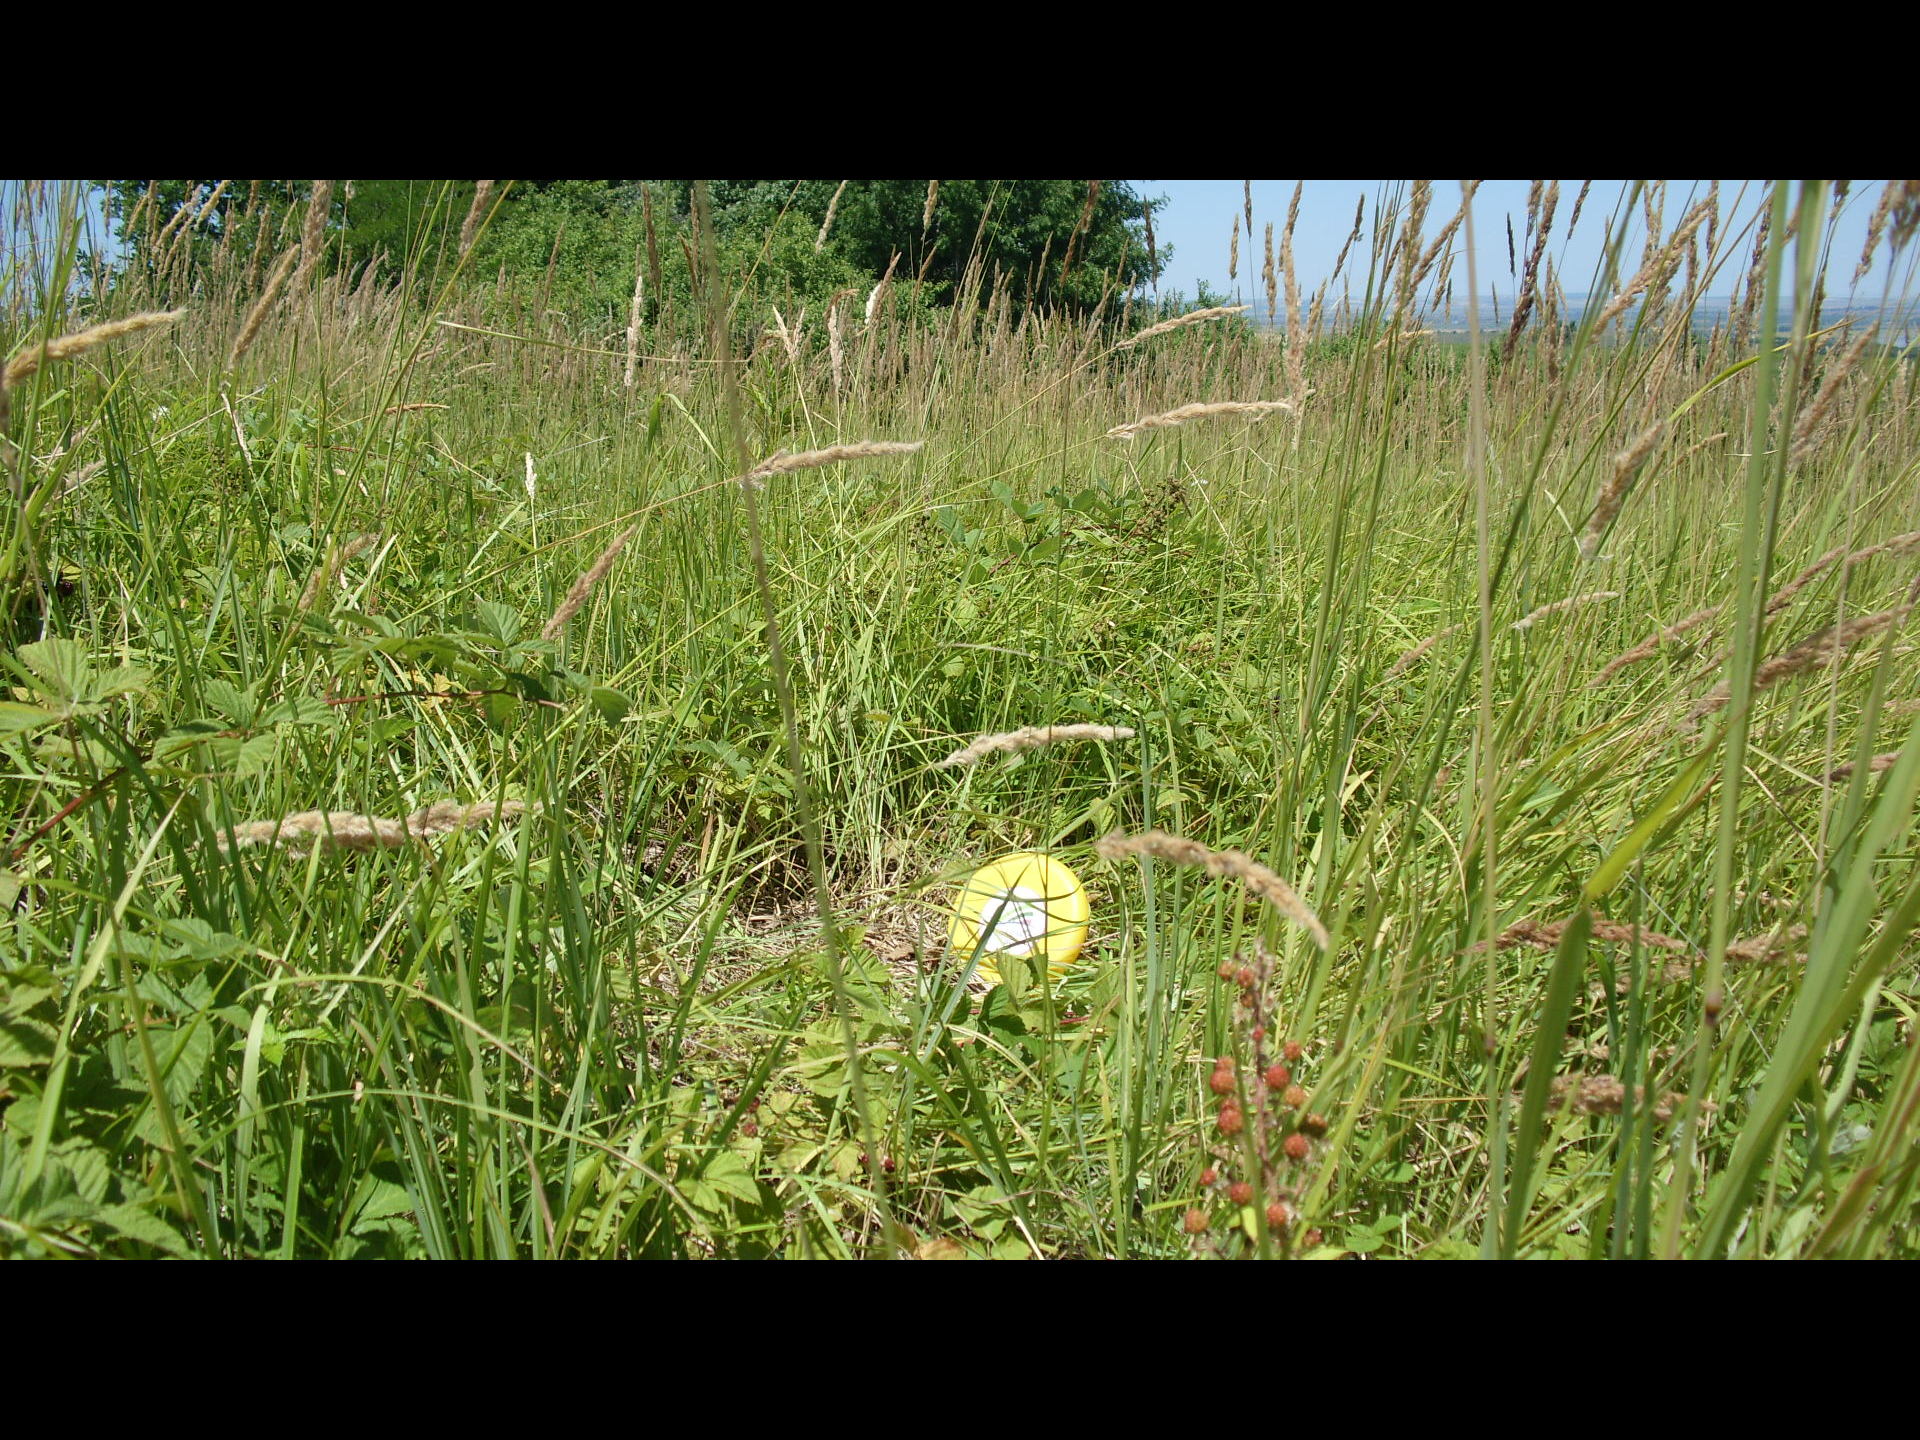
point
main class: Grassland
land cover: Grassland without tree/shrub cover
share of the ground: > 75 %
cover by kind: herbaceous plants 100 %
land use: Agriculture (excluding fallow land and kitchen gardens)
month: July
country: BG
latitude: 43.8624
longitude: 22.8158
